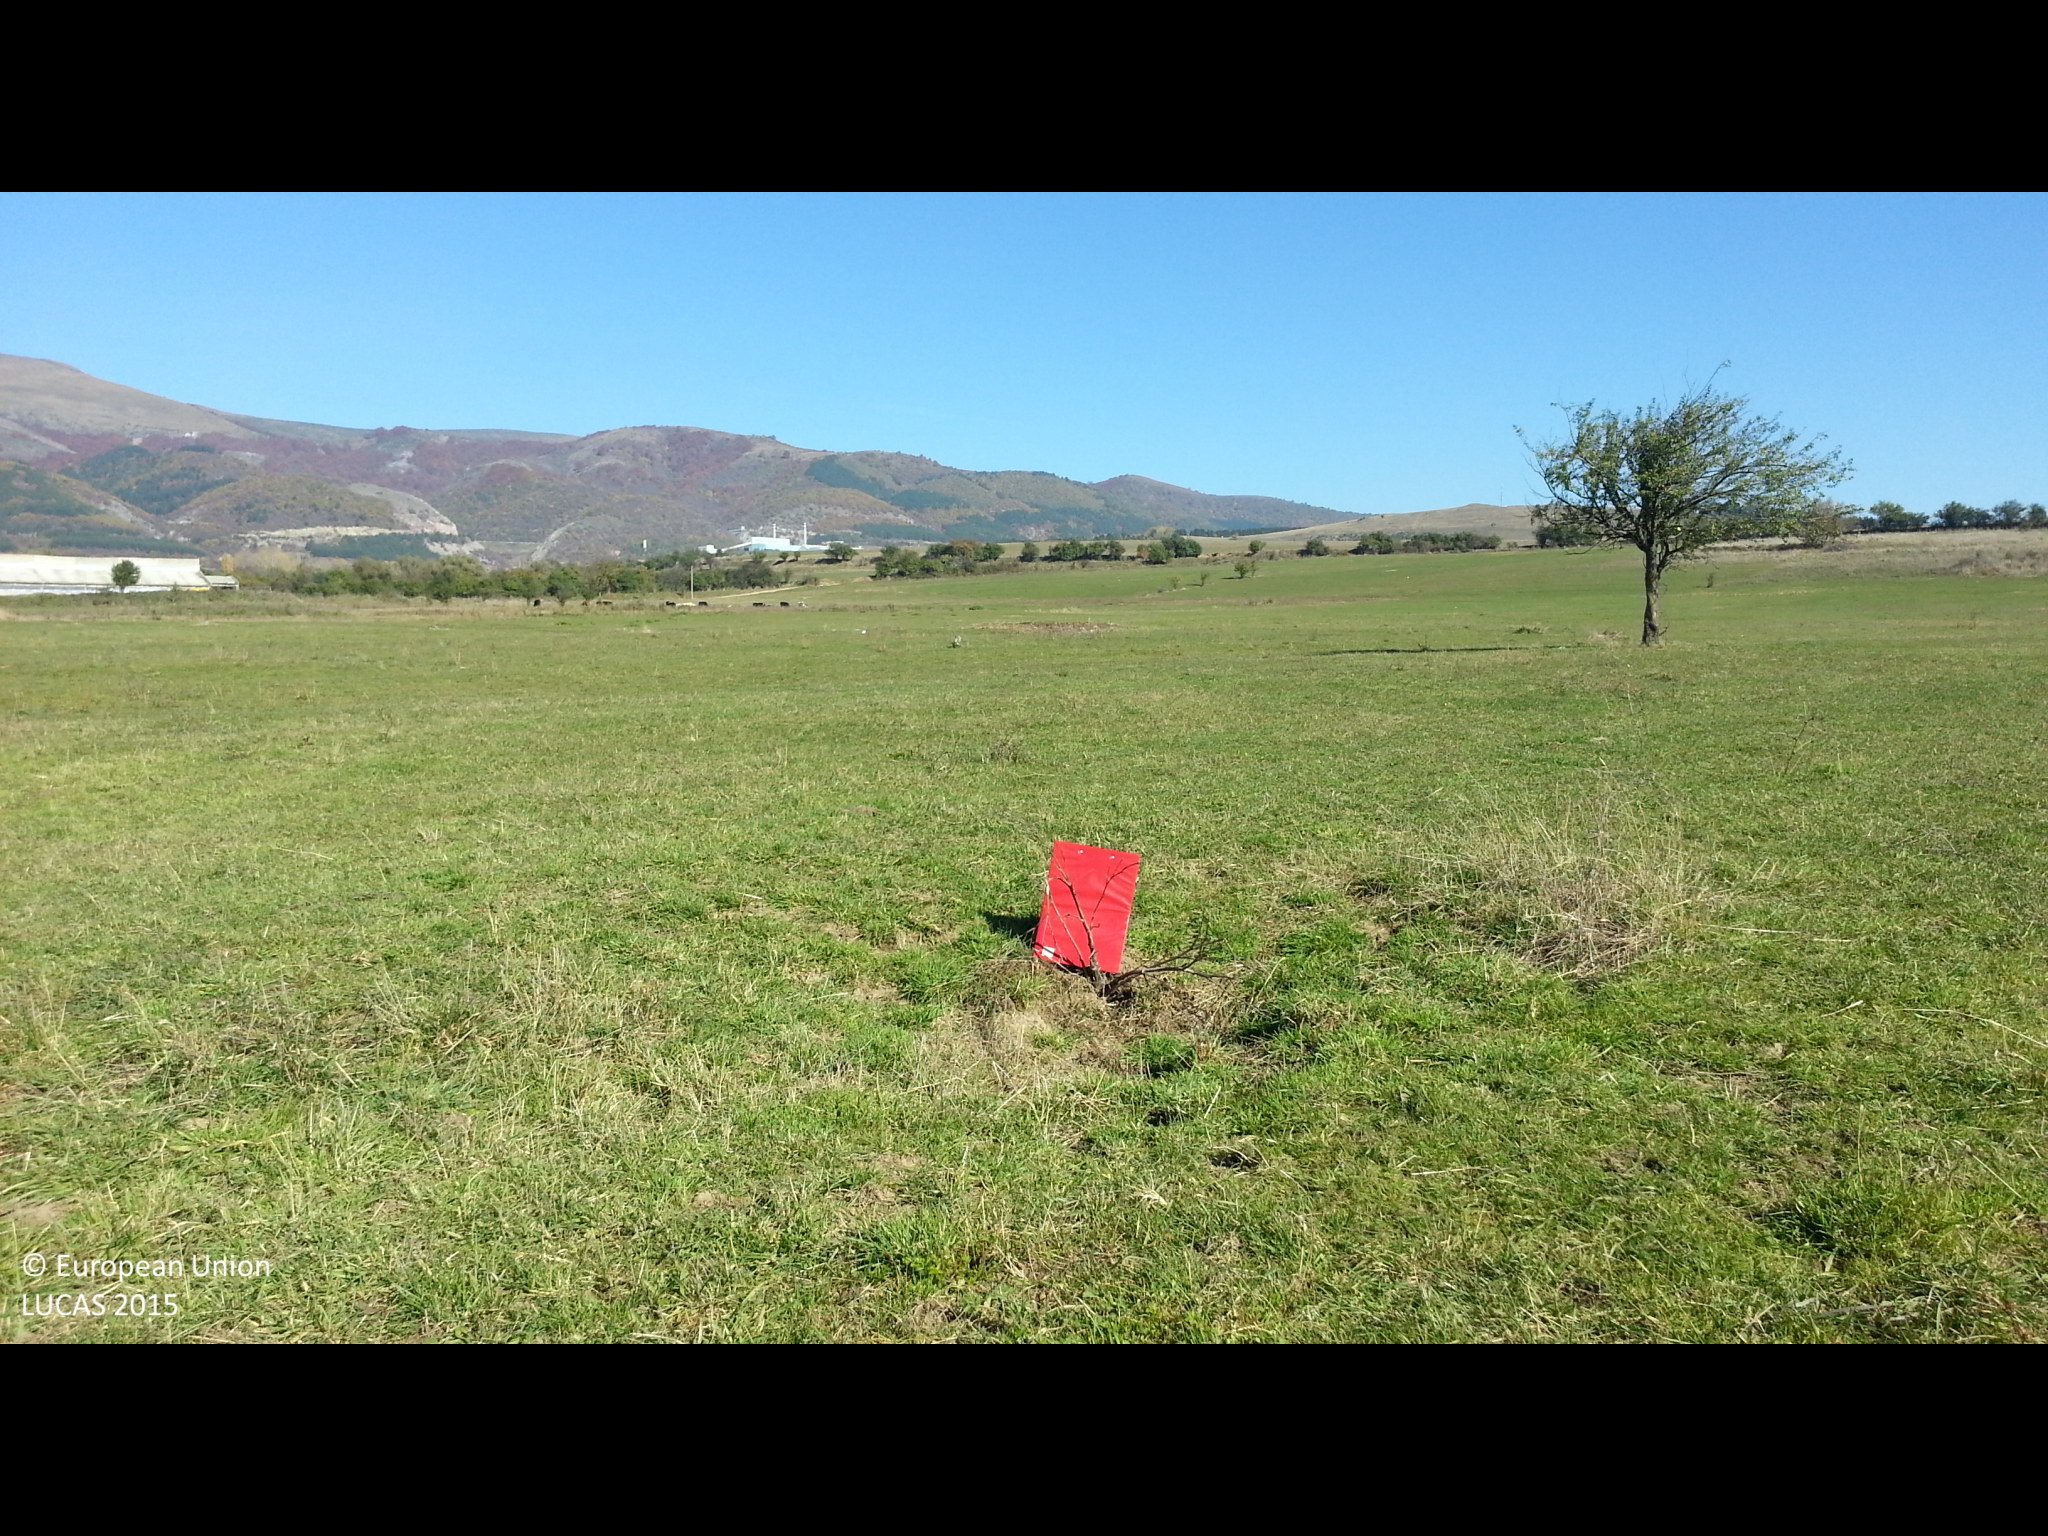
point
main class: Grassland
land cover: Grassland without tree/shrub cover
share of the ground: > 75 %
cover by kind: herbaceous plants 100 %
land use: Agriculture (excluding fallow land and kitchen gardens)
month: November
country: BG
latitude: 42.6835
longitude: 23.9940
